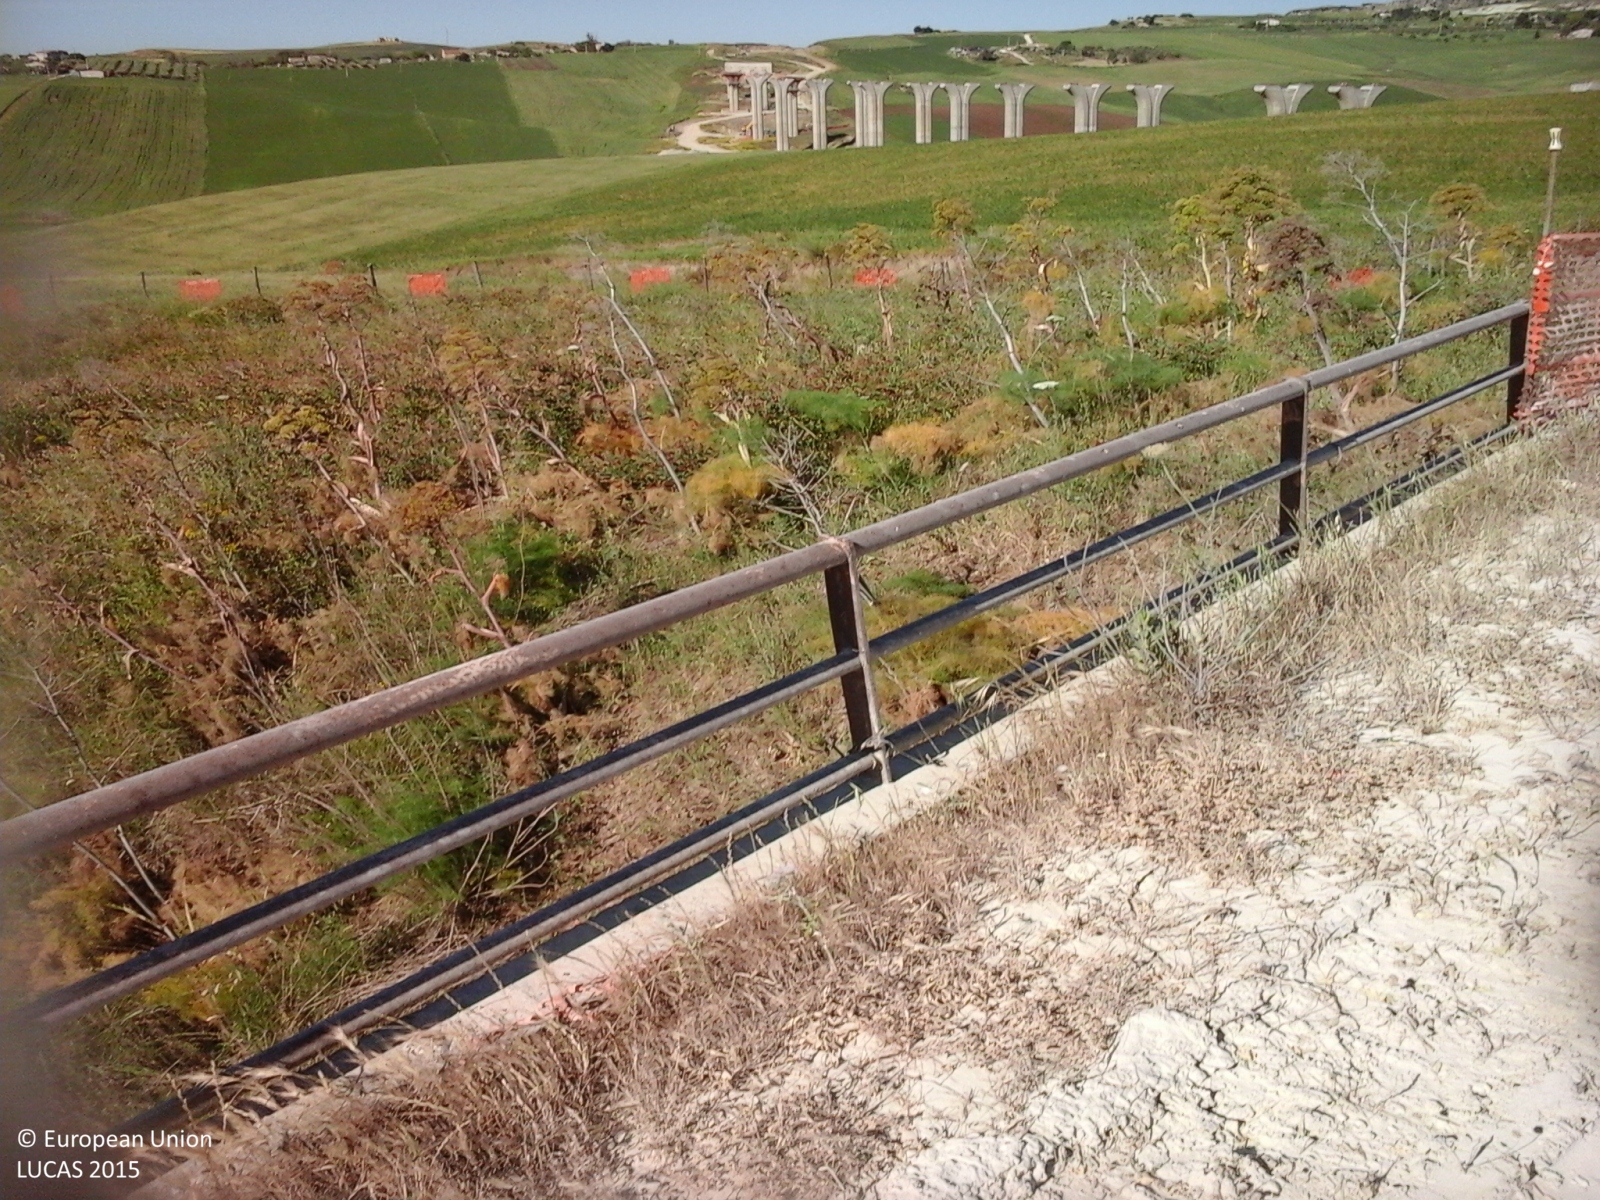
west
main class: Cropland
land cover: Durum wheat
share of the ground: > 75 %
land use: Agriculture (excluding fallow land and kitchen gardens)
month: May
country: IT
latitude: 37.4298
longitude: 13.9368
